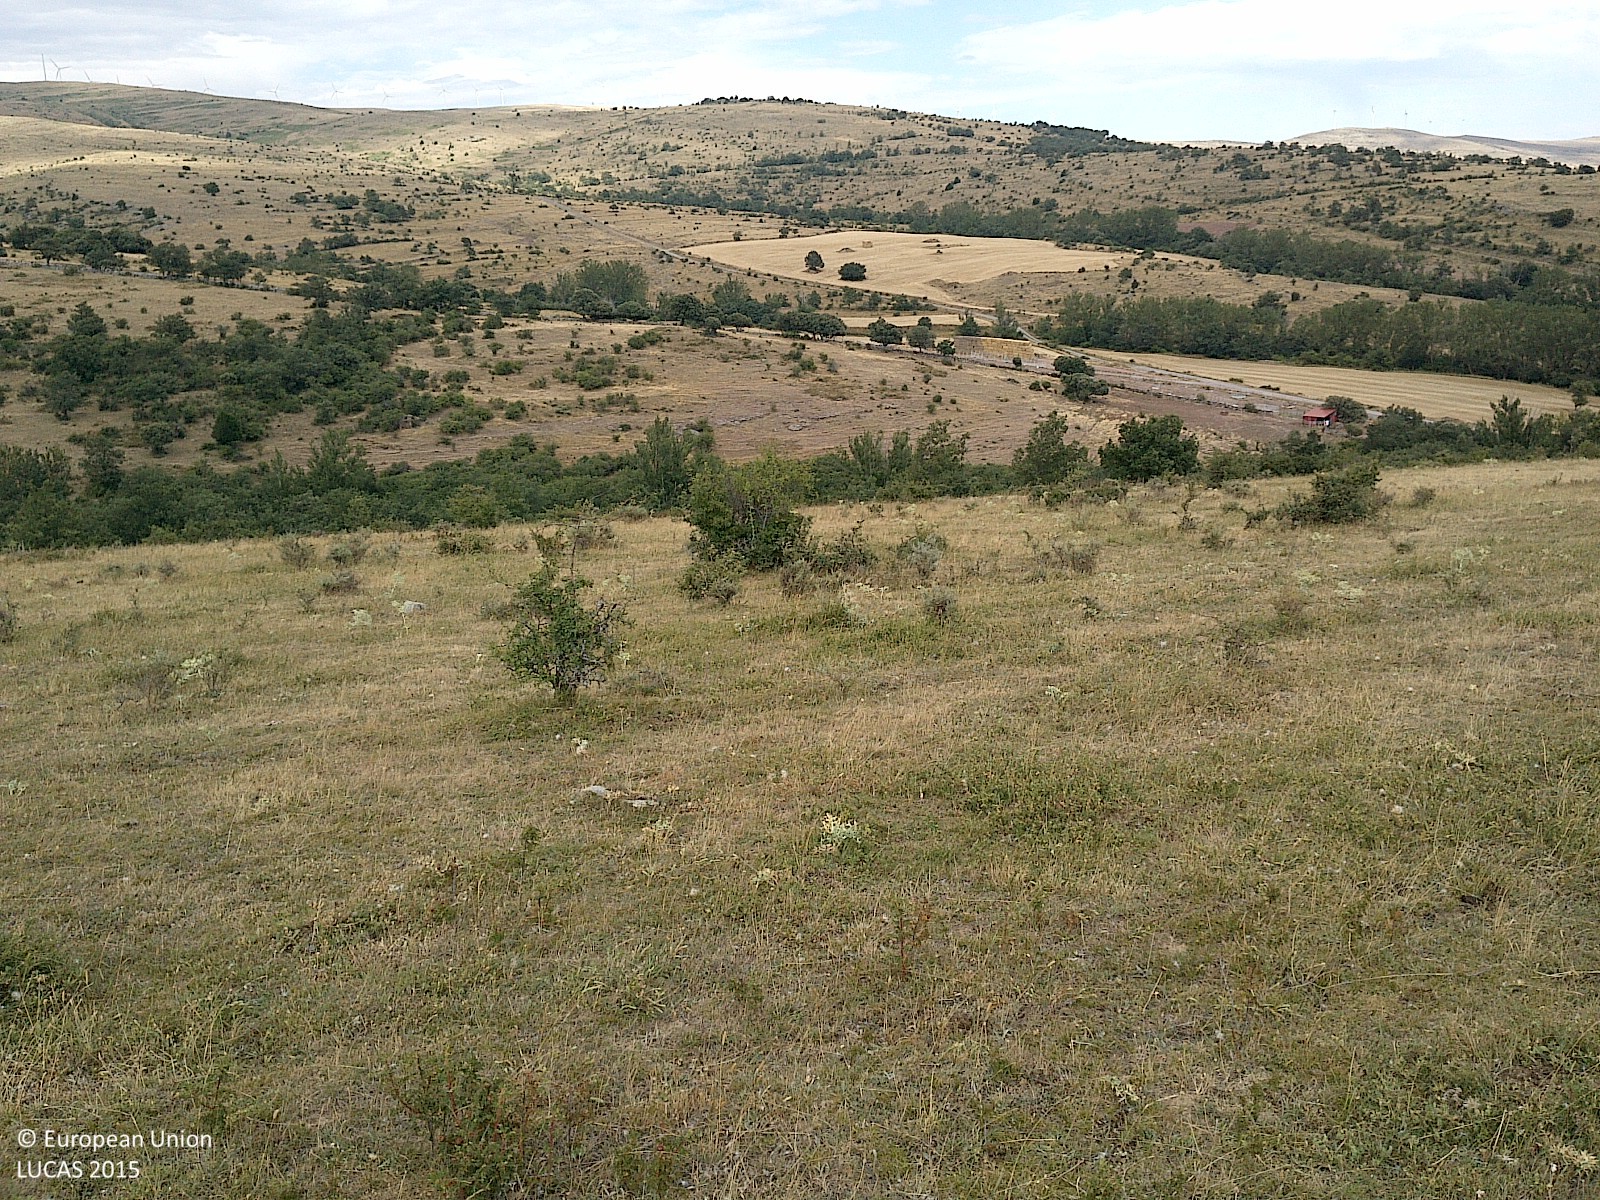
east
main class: Grassland
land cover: Grassland without tree/shrub cover
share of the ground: > 75 %
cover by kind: herbaceous plants 95 %, shrubs 5 %
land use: Agriculture (excluding fallow land and kitchen gardens)
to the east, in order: Grassland without tree/shrub cover; Grassland with sparse tree/shrub cover; Broadleaved woodland
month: July
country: ES
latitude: 41.9344
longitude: -2.3277
